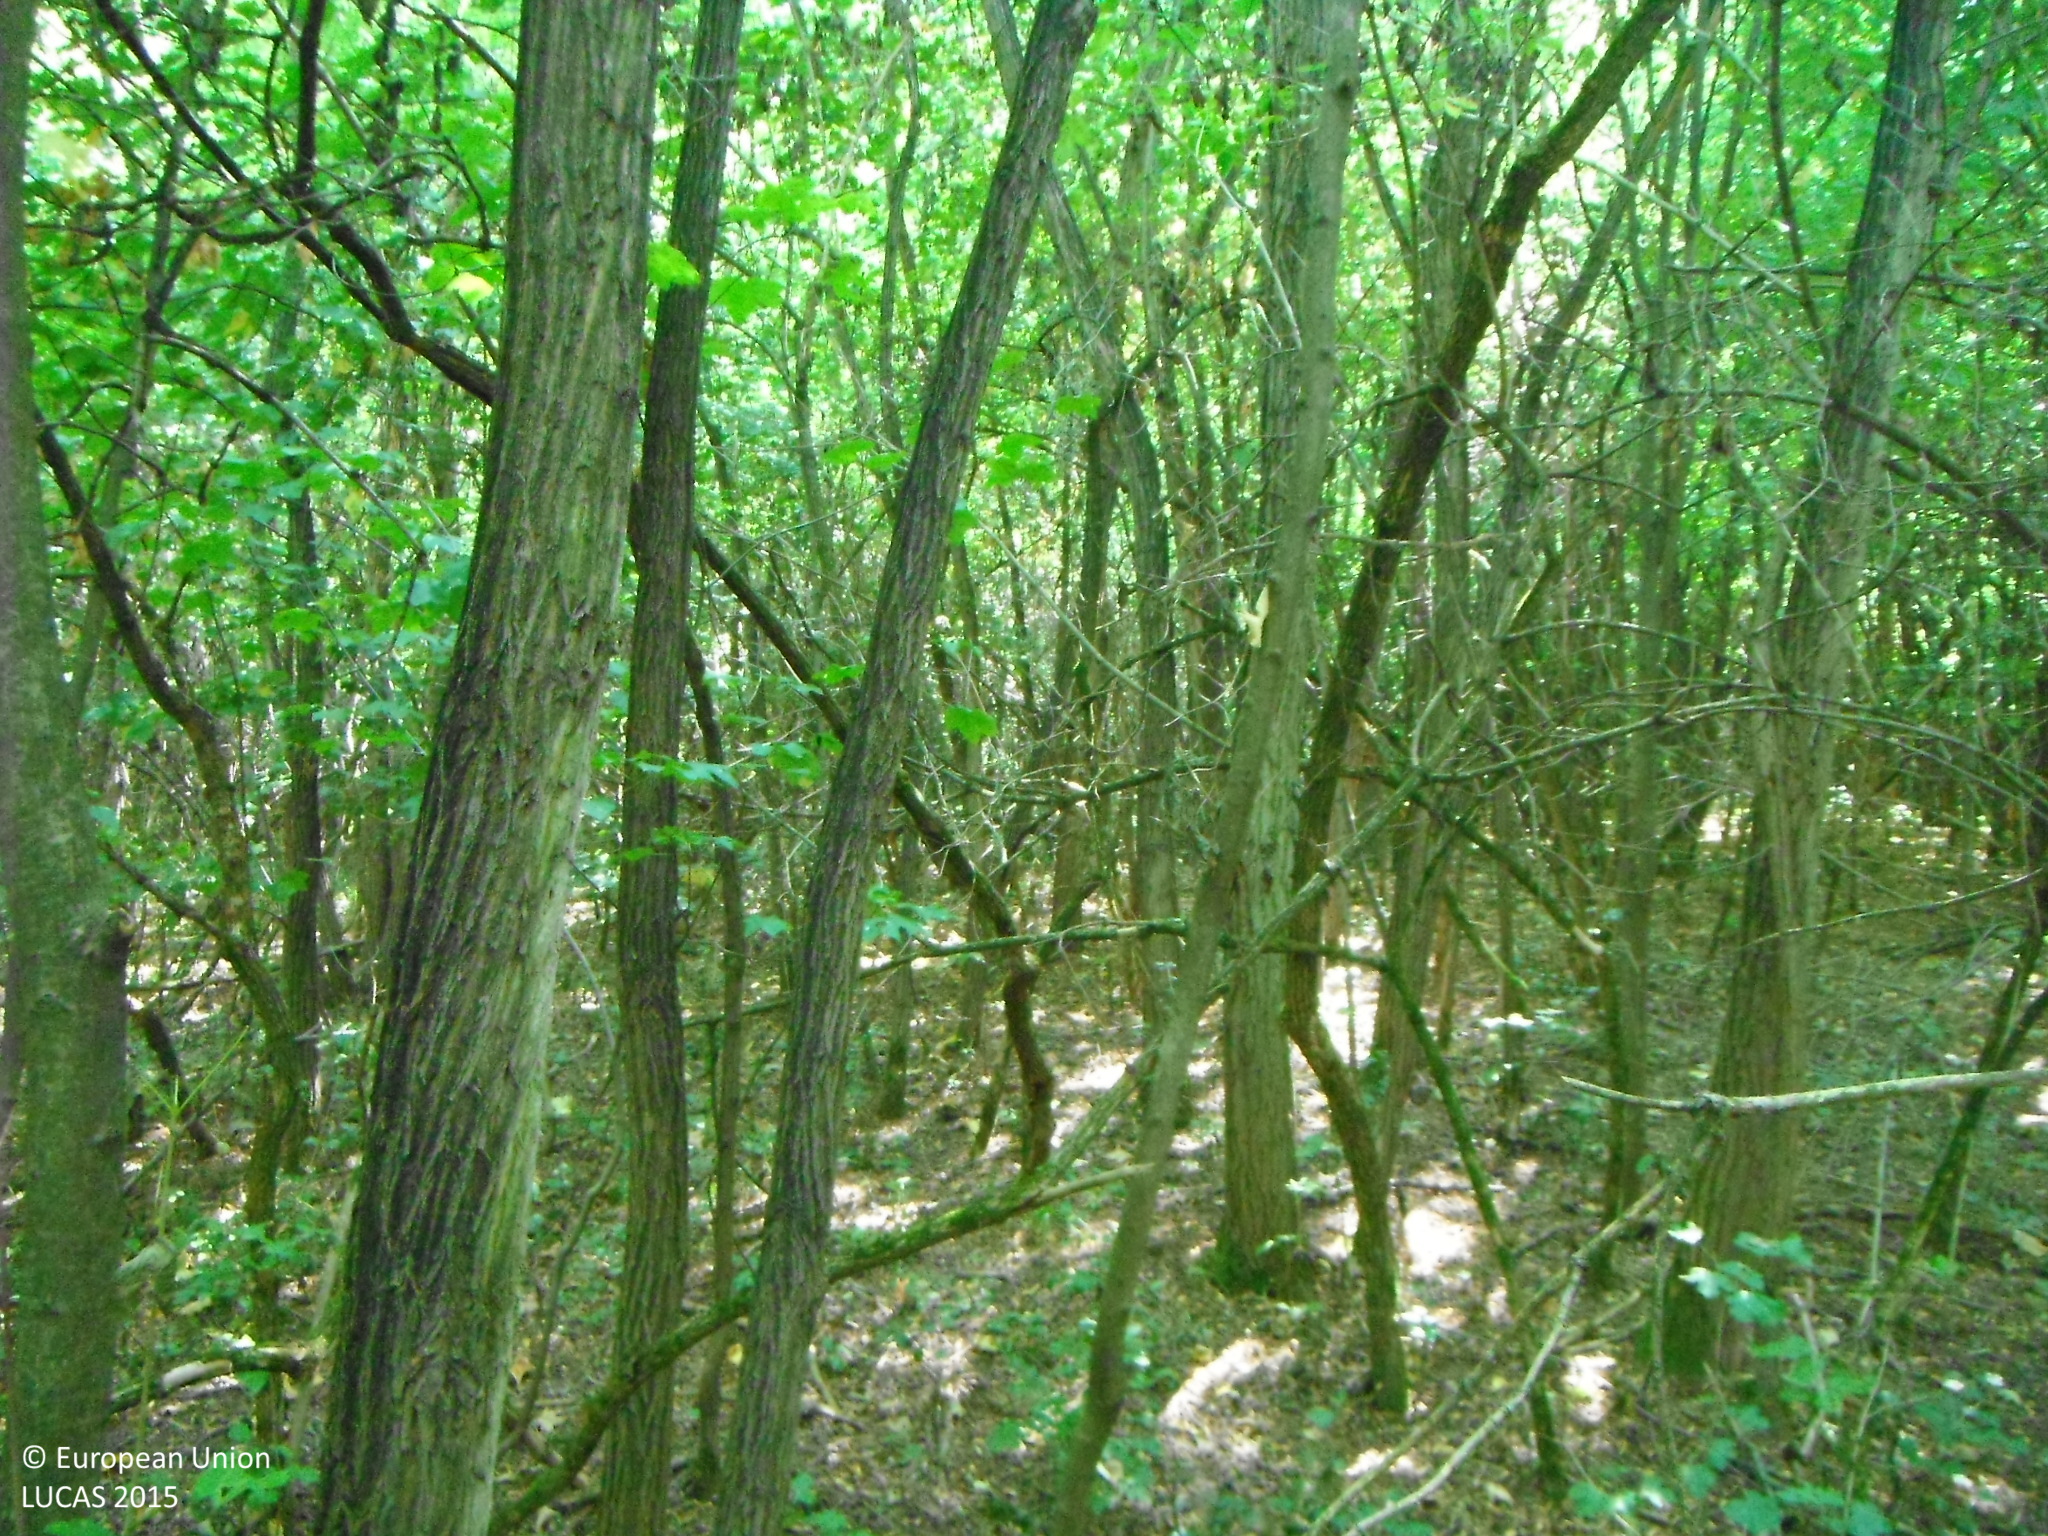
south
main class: Woodland
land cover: Broadleaved woodland
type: mesophytic deciduous forest
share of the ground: > 75 %
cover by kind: broadleaved forest trees 100 %
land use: Forestry
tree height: > 5 m
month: August
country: SK
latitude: 47.8302
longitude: 18.6324
